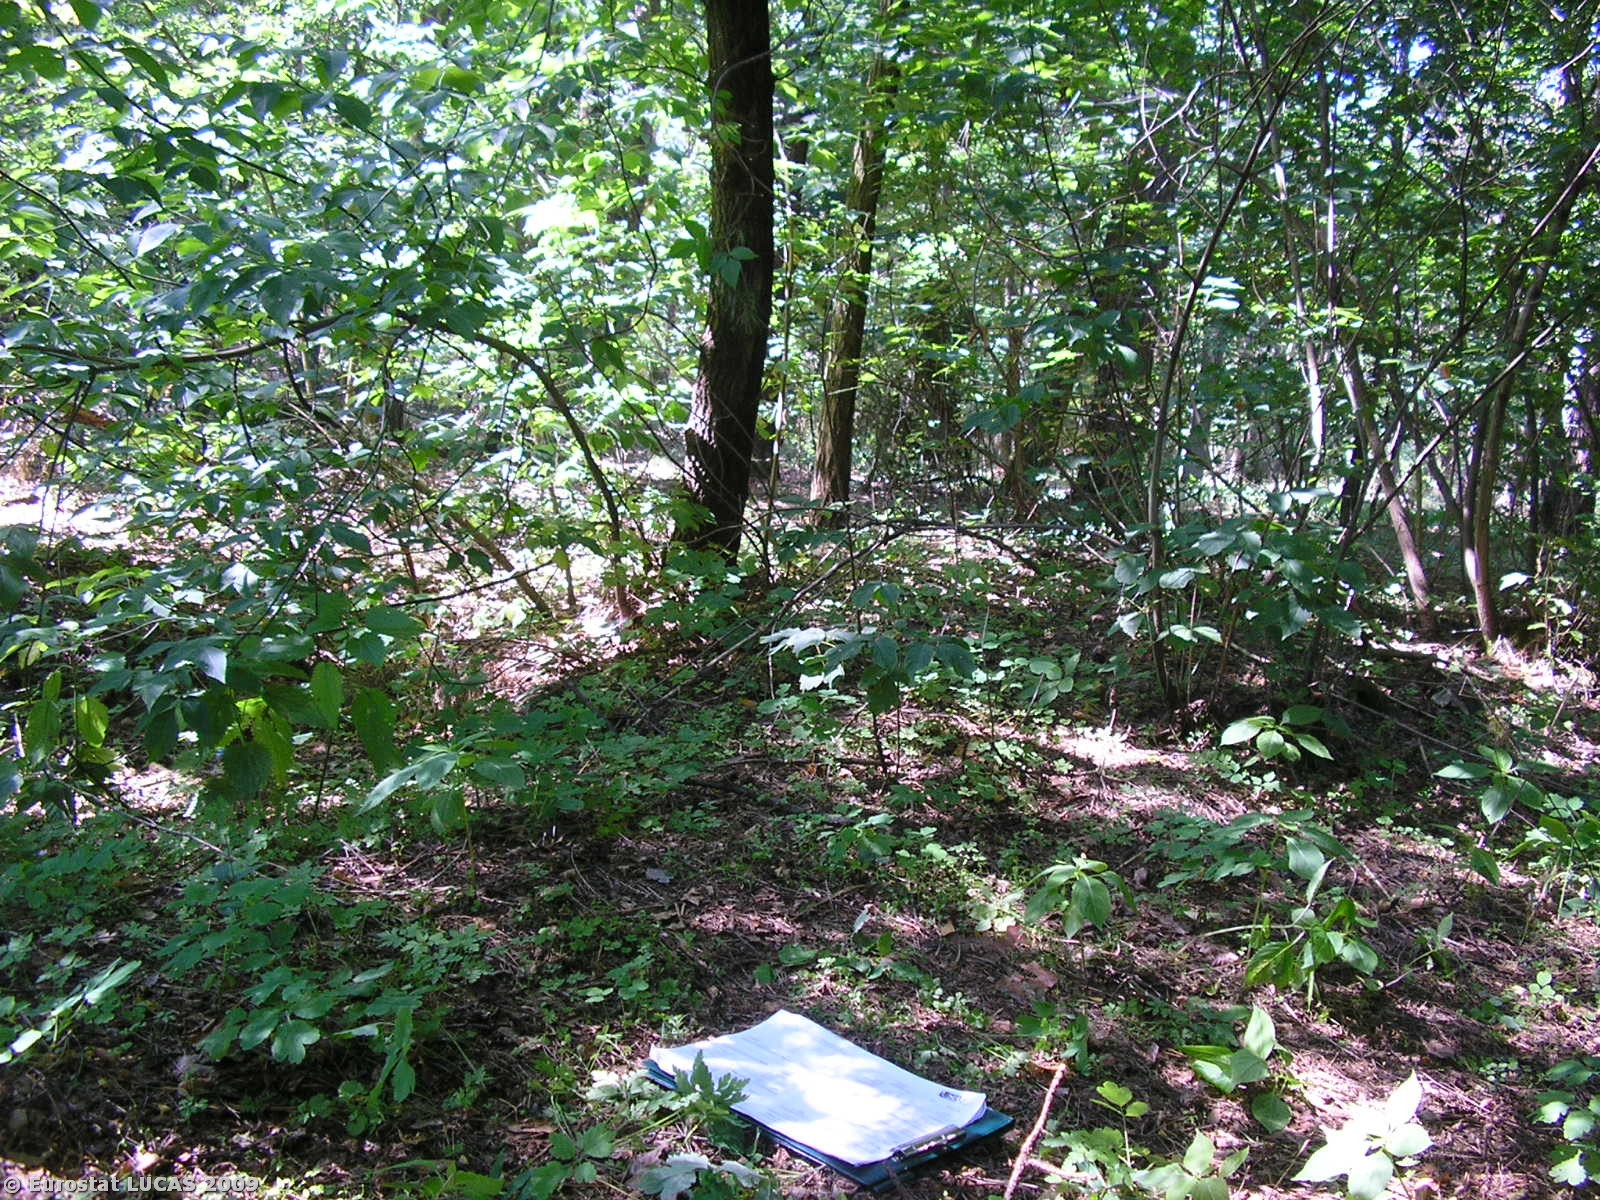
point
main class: Woodland
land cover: Mixed woodland
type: hemiboreal forest and nemoral coniferous forest and mixed broadleaved-coniferous forest
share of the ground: > 75 %
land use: Forestry
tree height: > 5 m
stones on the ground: < 10 %
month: July
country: PL
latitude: 52.4395
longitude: 21.0633
